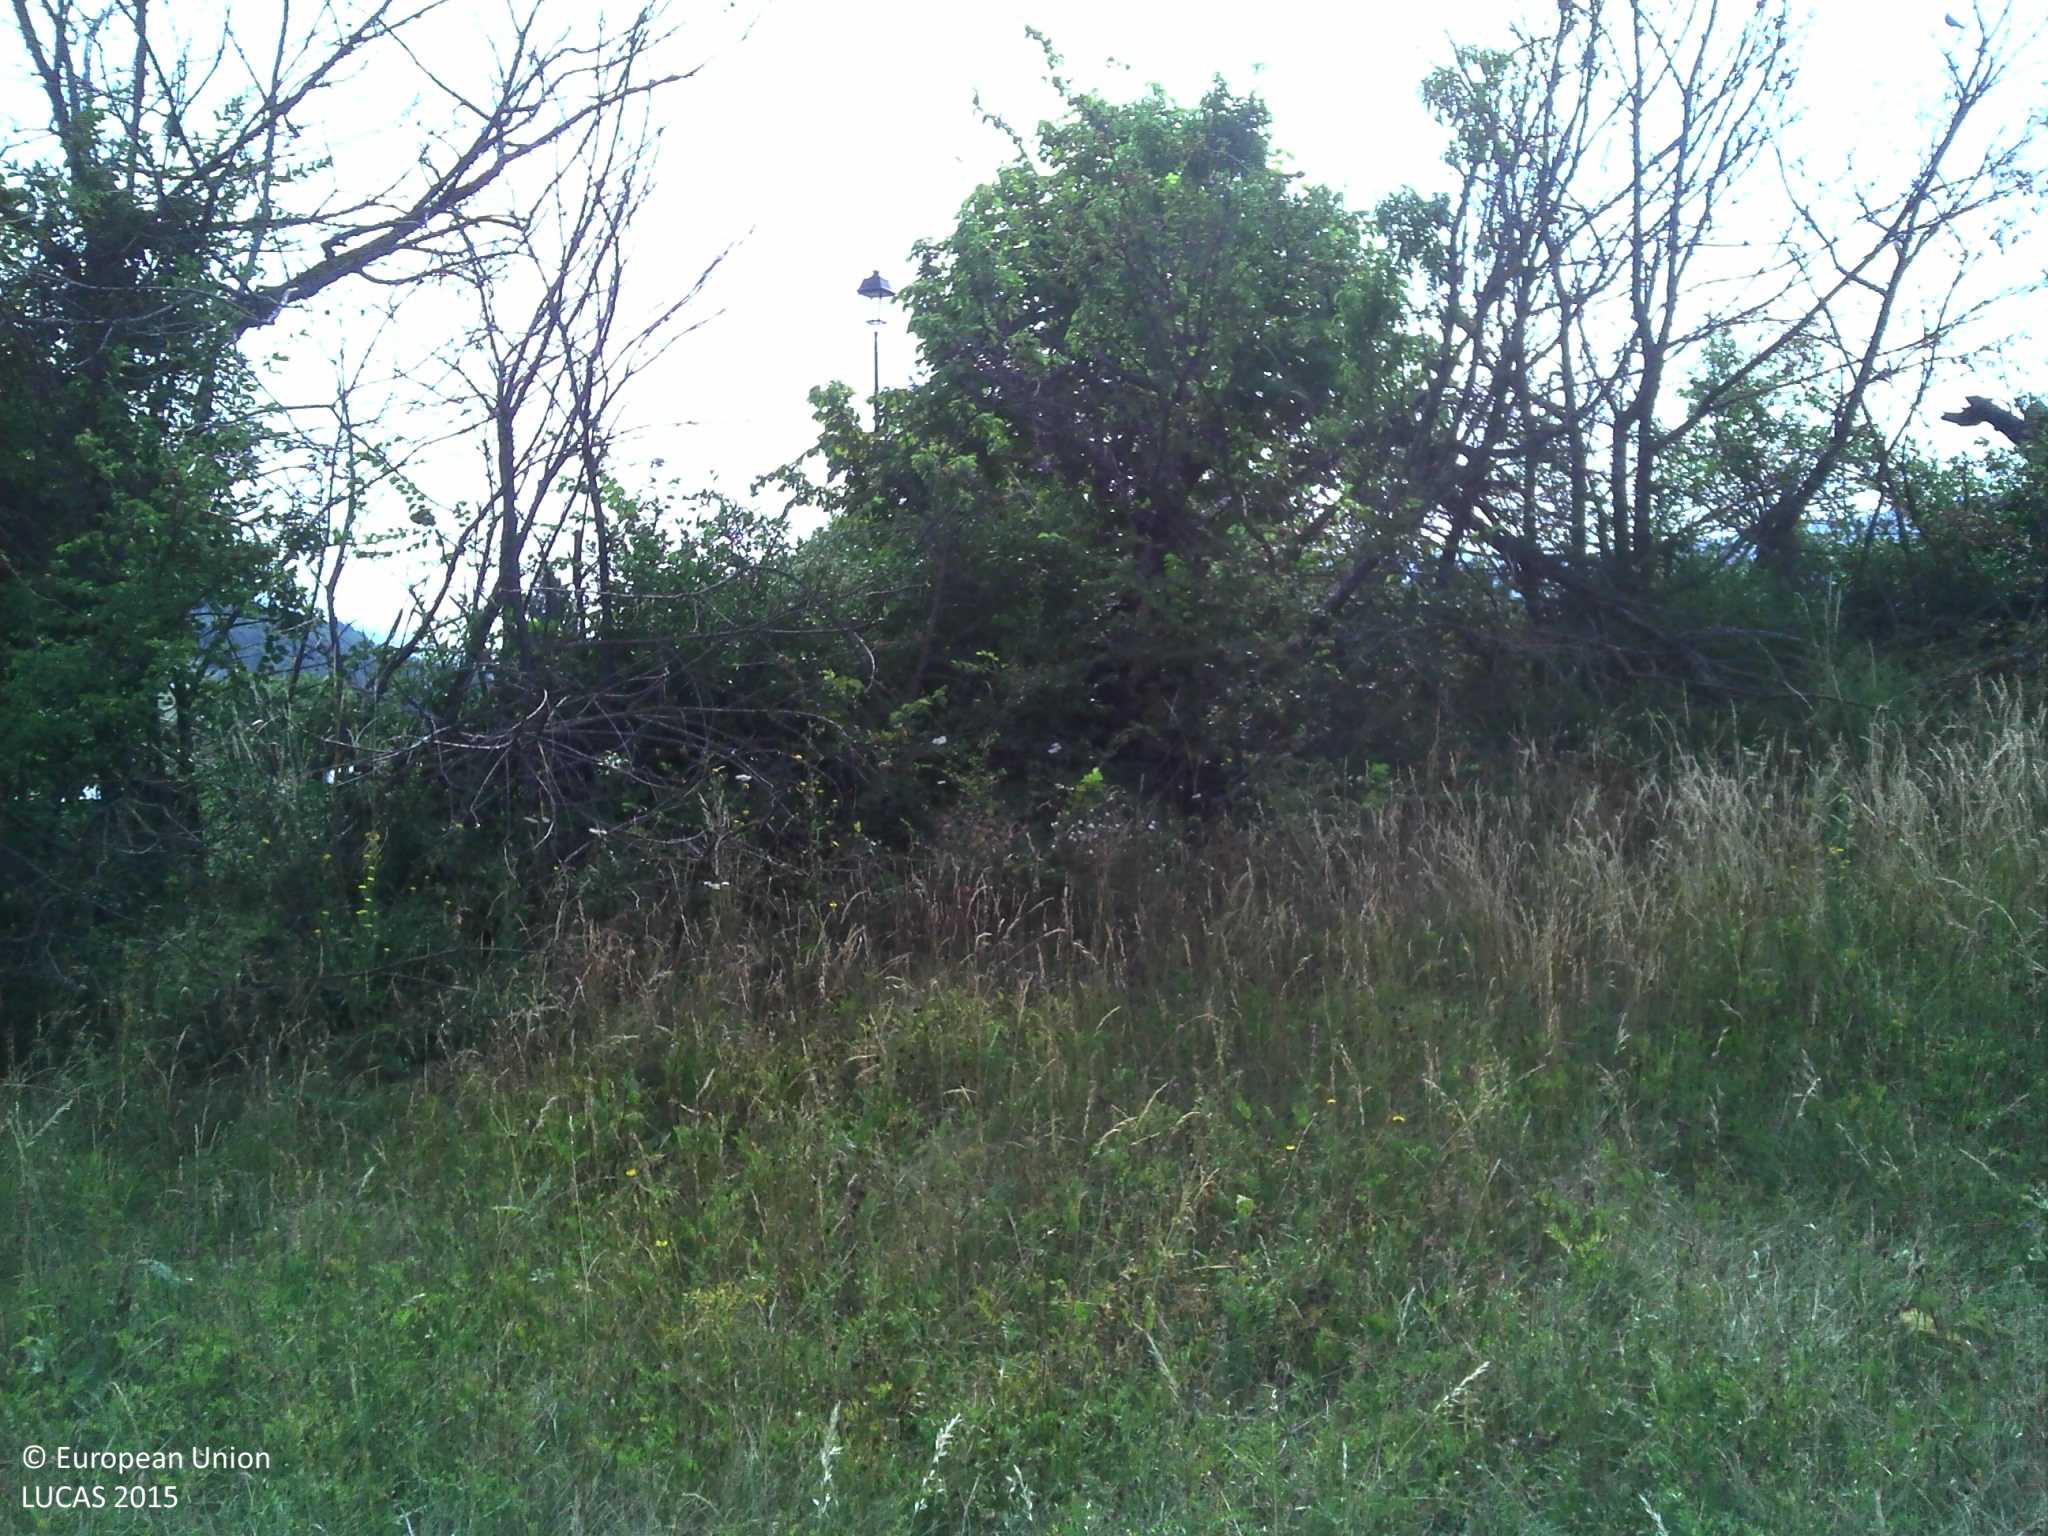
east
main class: Grassland
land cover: Grassland without tree/shrub cover
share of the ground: > 75 %
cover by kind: herbaceous plants 100 %
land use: Agriculture (excluding fallow land and kitchen gardens)
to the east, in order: Grassland without tree/shrub cover; Managed hedges; Artificial constructions in urban areas; Dry stone walls; Grassland without tree/shrub cover; Pine dominated coniferous woodland; Grassland without tree/shrub cover; Fences; Tracks; Fences; Grassland without tree/shrub cover; Broadleaved woodland
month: July
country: FR
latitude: 43.7805
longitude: 6.3427
